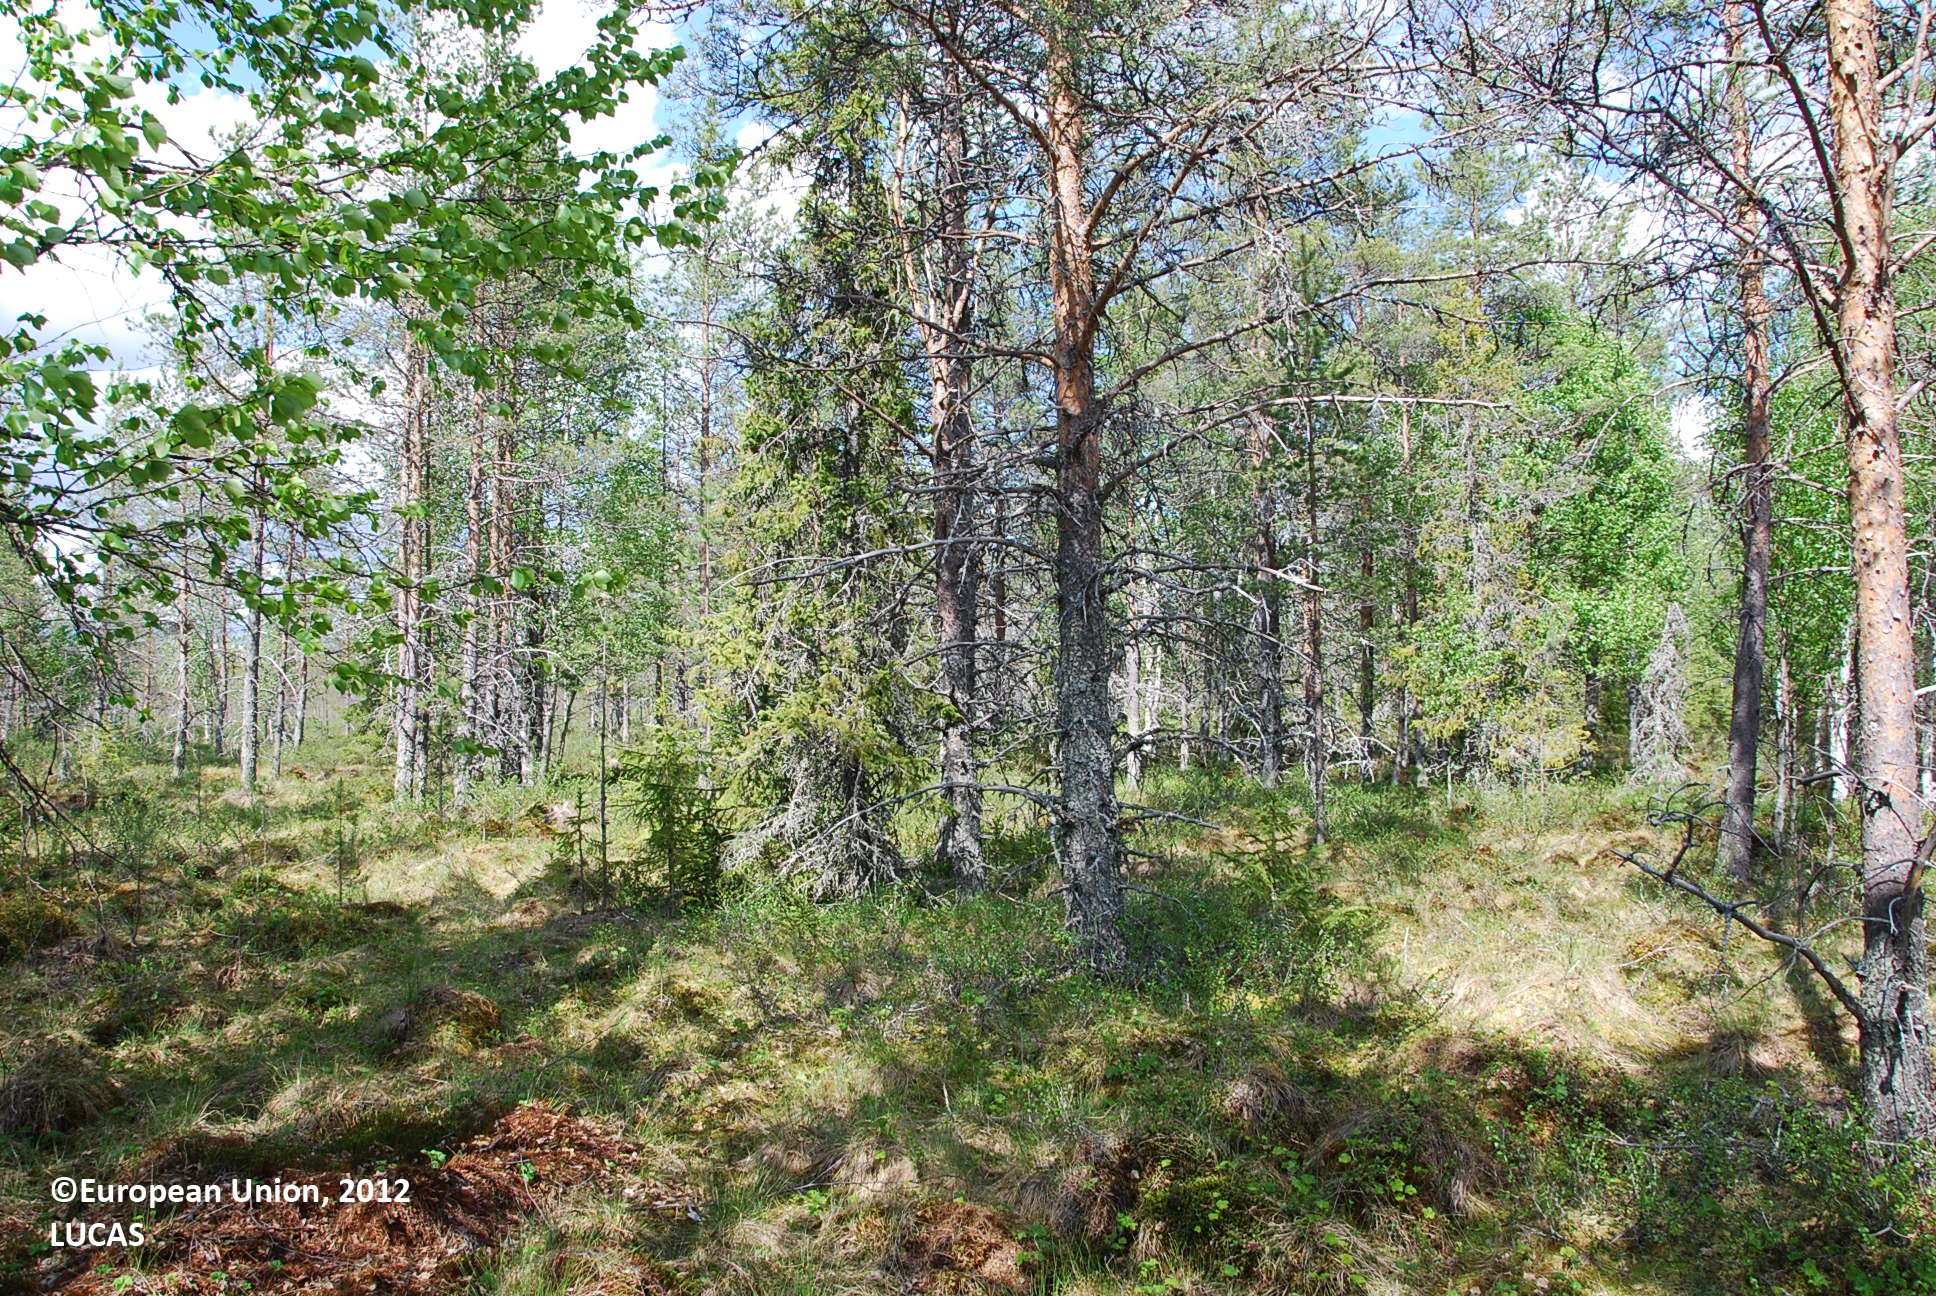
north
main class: Woodland
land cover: Pine dominated mixed woodland
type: boreal forest
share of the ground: 50 - 75 %
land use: Forestry
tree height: > 5 m
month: June
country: FI
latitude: 66.0278
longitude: 27.6164
